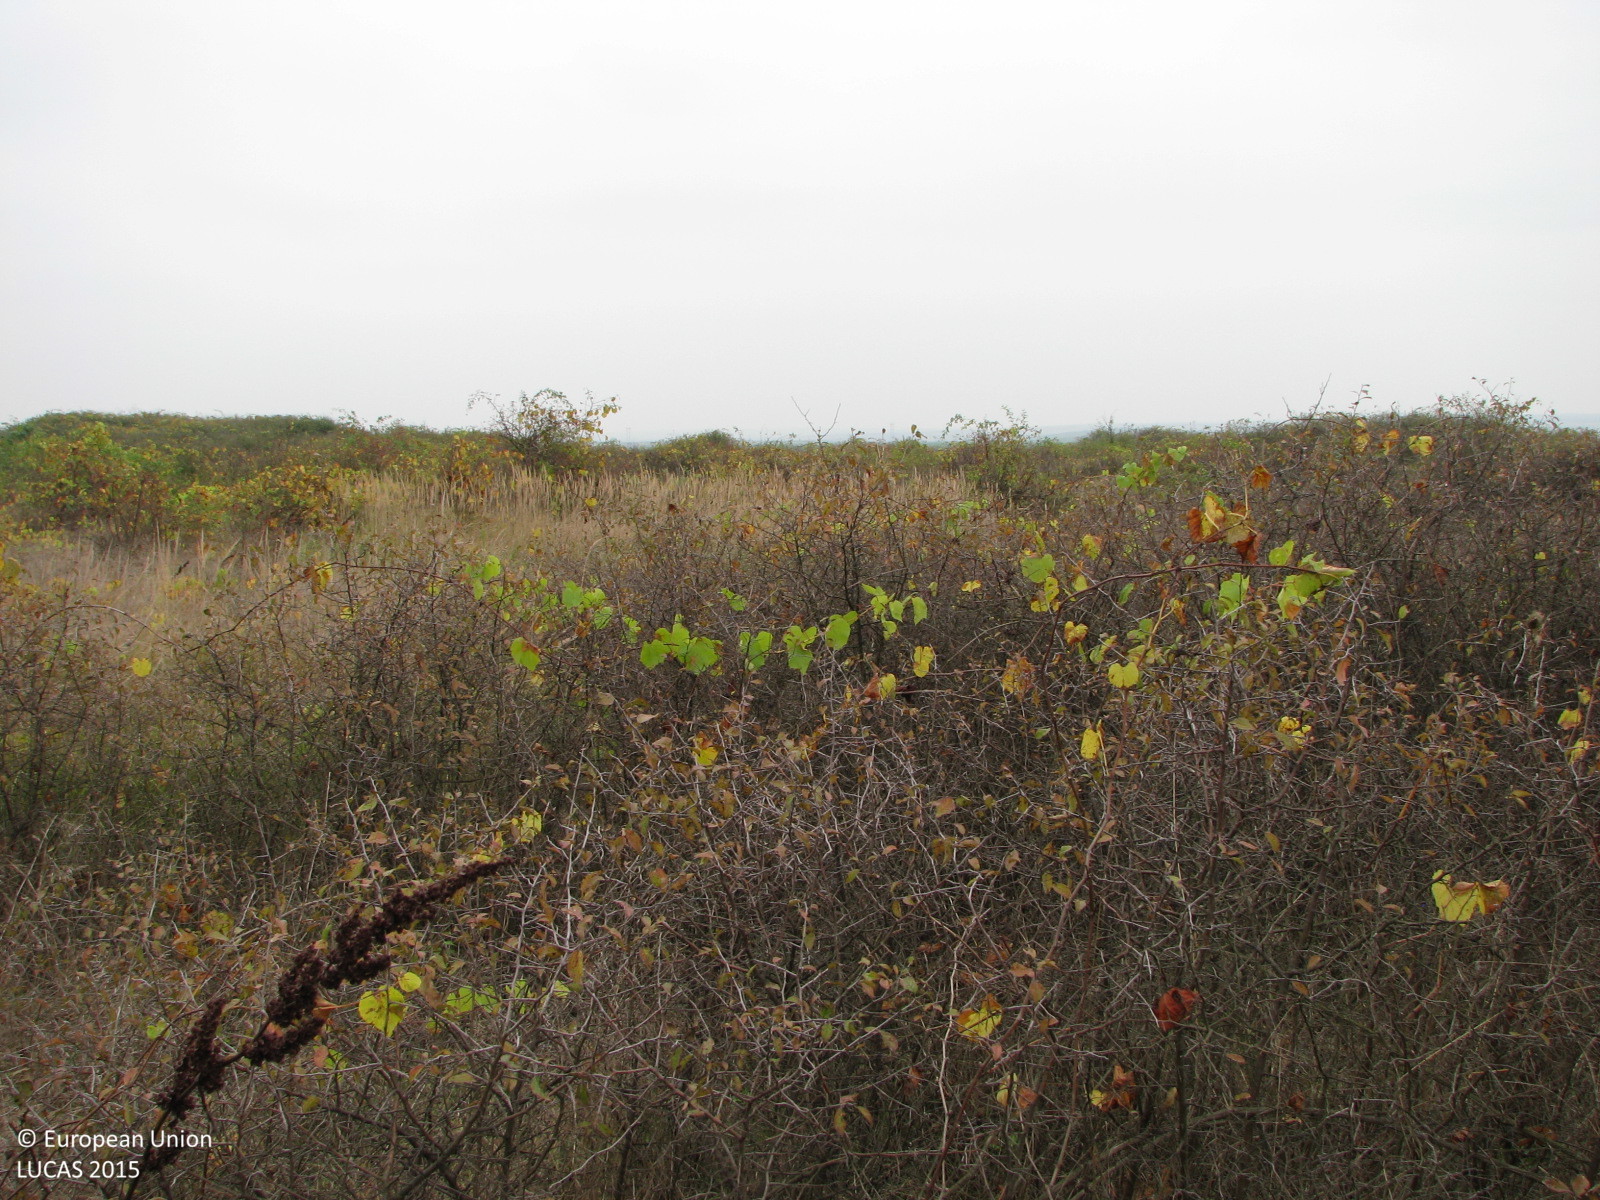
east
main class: Shrubland
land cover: Shrubland without tree cover
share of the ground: > 75 %
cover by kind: shrubs 80 %, herbaceous plants 20 %
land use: Semi-natural and natural areas not in use
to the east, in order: Shrubland without tree cover; Tracks; Other bare soil
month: October
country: BG
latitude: 42.5760
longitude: 26.7291
